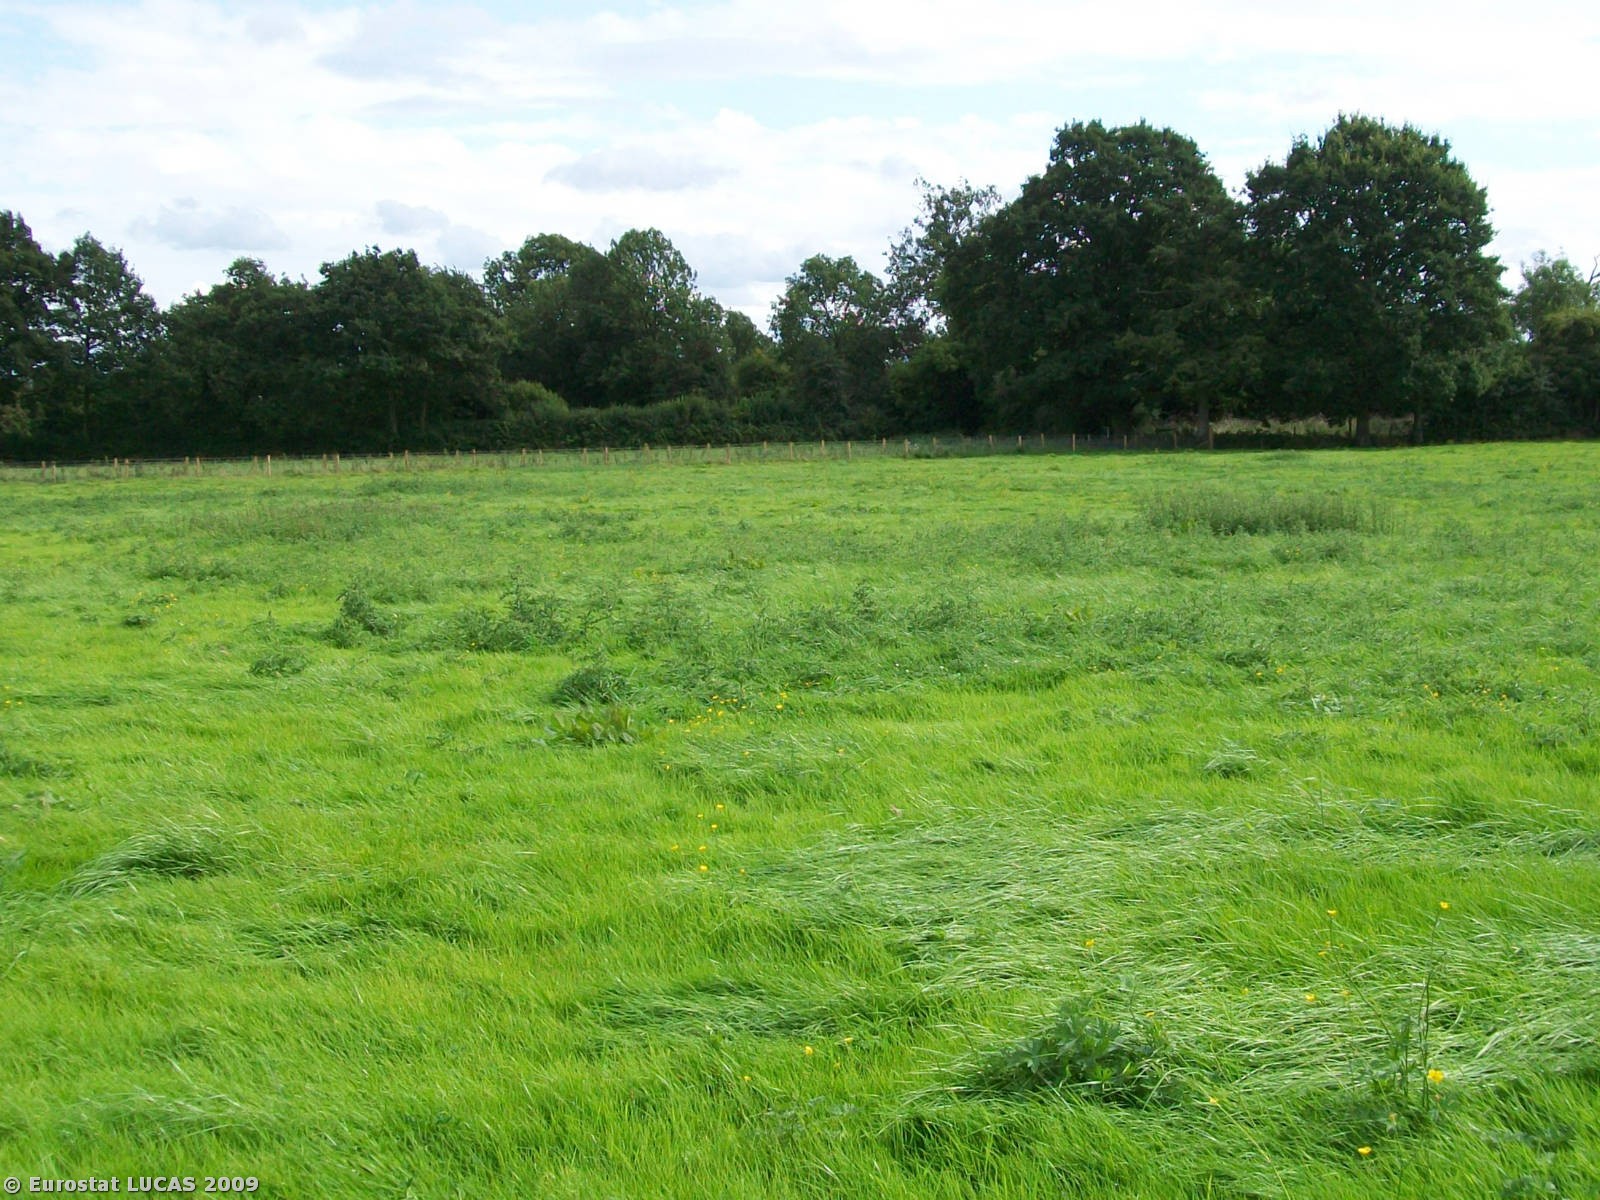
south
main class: Grassland
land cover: Grassland without tree/shrub cover
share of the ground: > 75 %
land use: Agriculture (excluding fallow land and kitchen gardens)
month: August
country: GB
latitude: 51.8879
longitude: -2.4004
